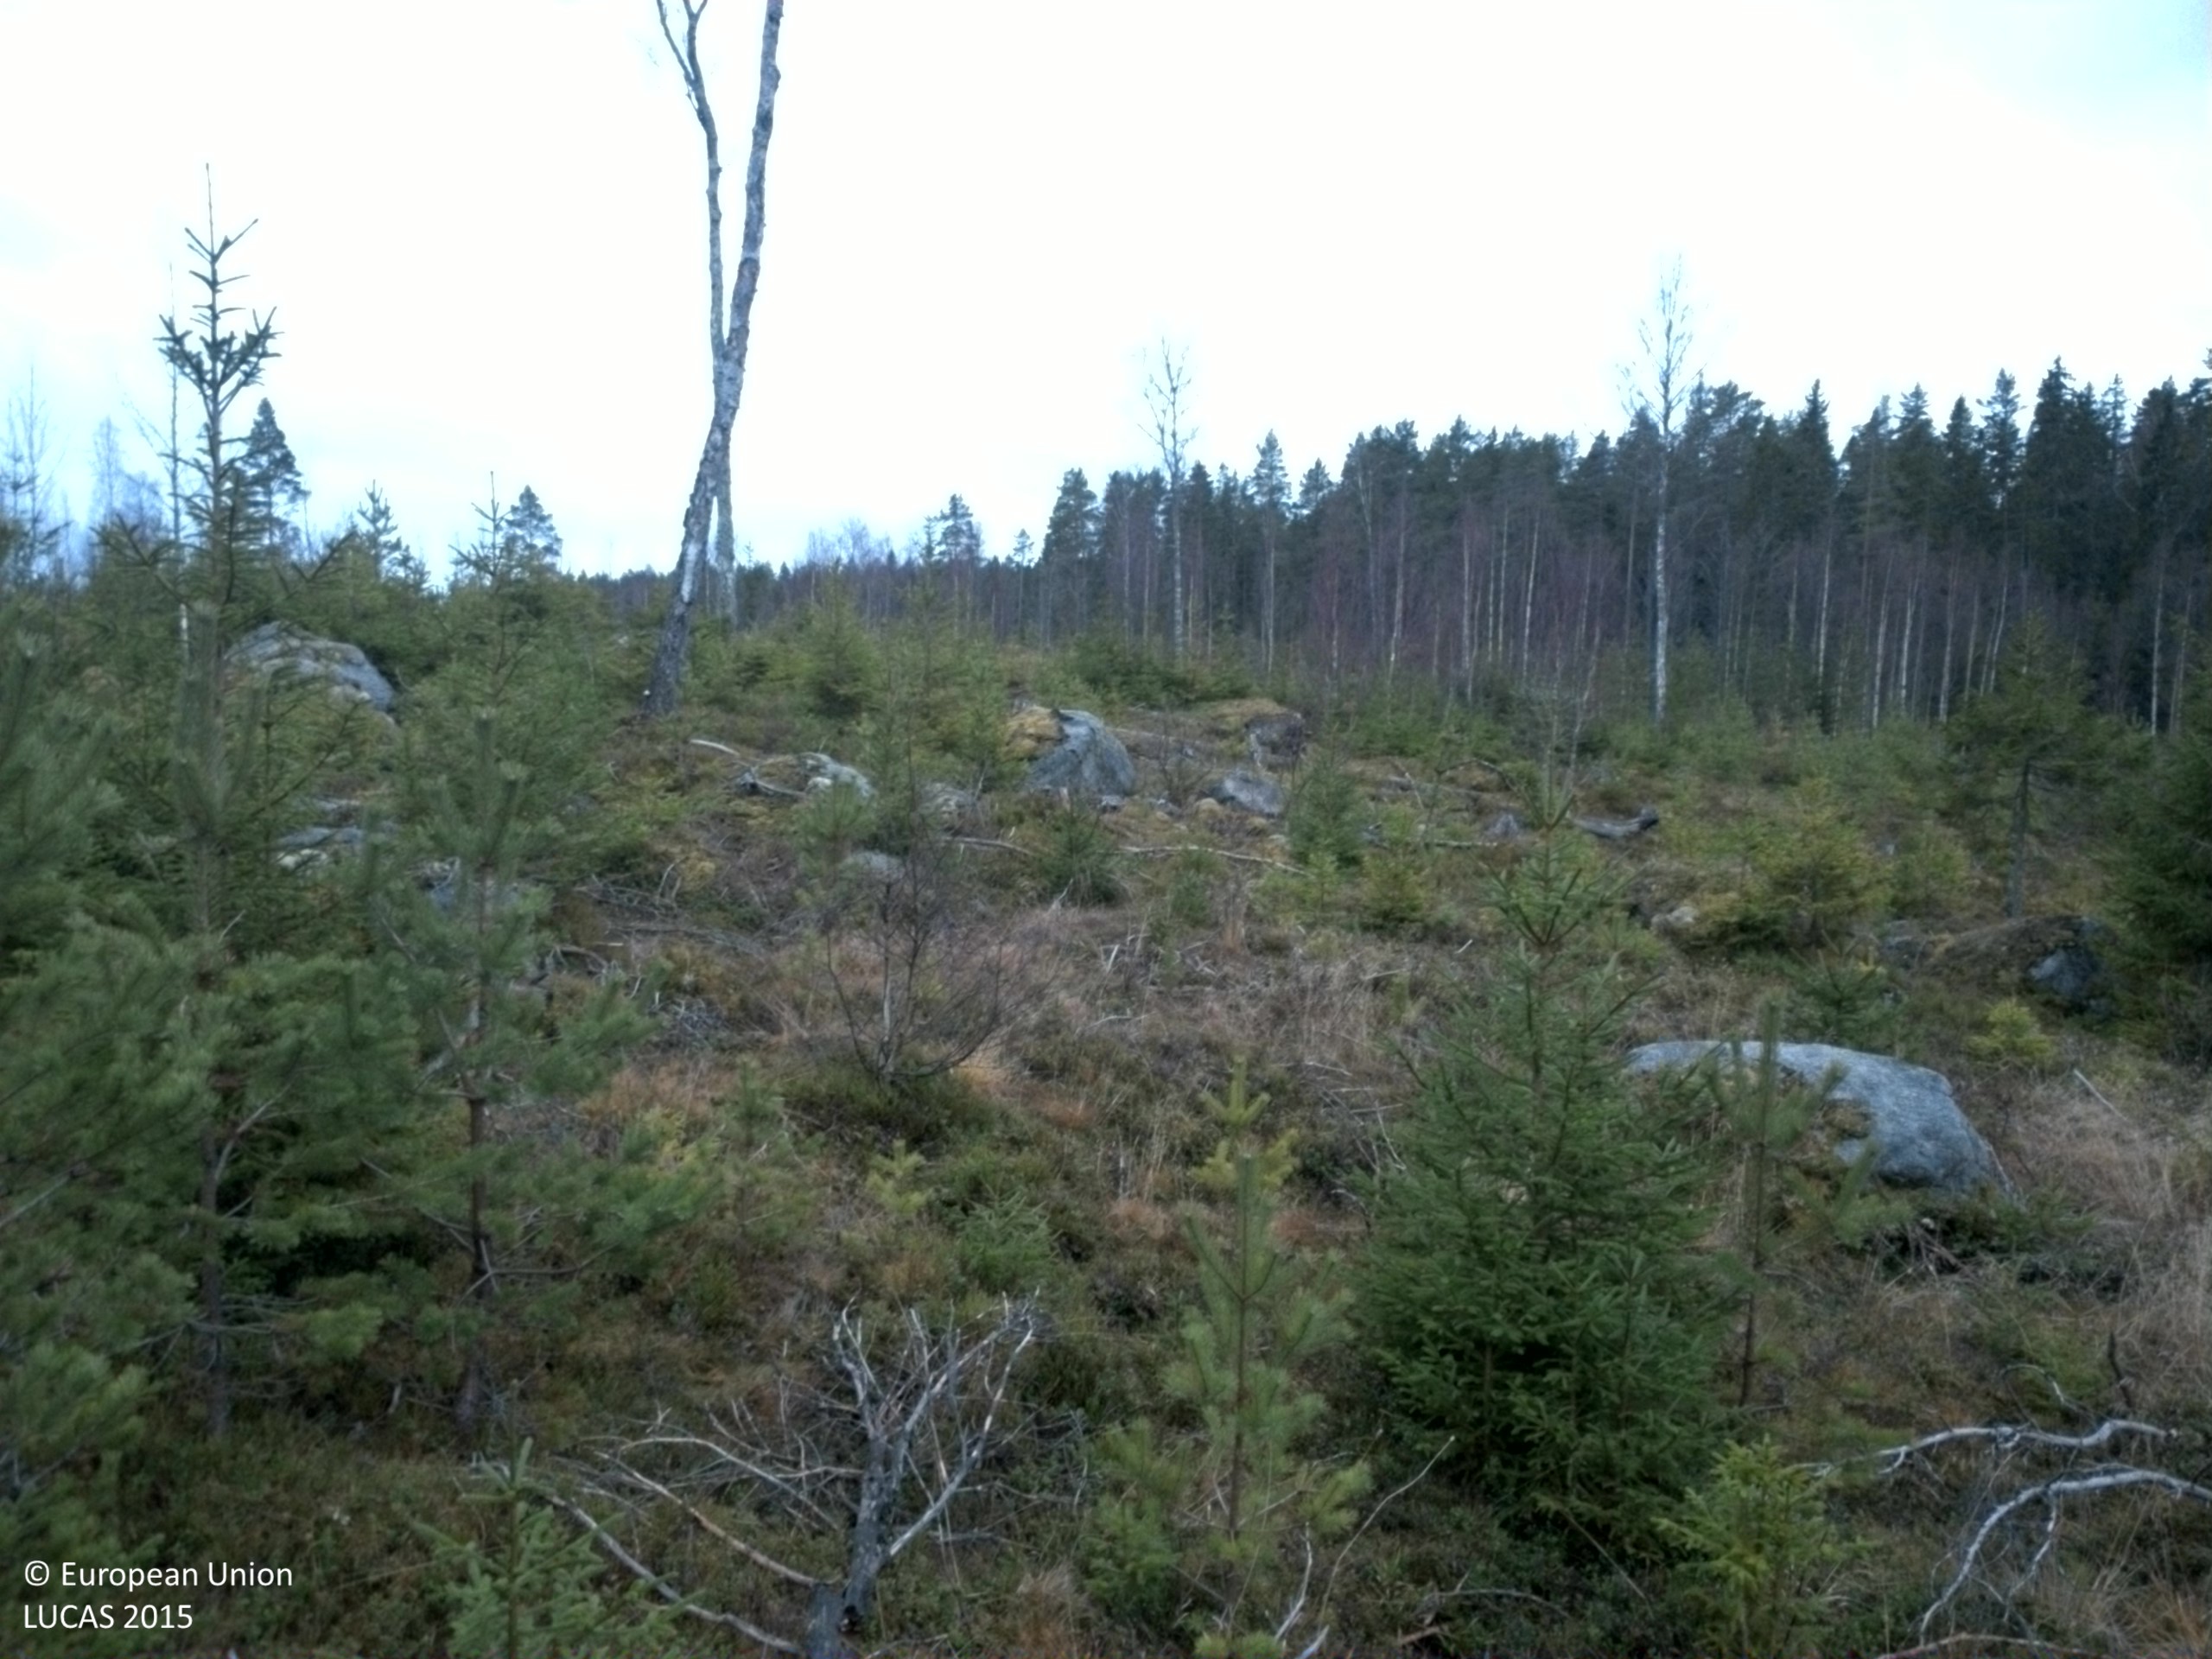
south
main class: Woodland
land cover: Other mixed woodland
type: boreal forest
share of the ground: 25 - 50 %
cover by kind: shrubs 35 %, coniferous forest trees 25 %, lichens and mosses 20 %, broadleaved forest trees 10 %, herbaceous plants 5 %, consolidated bare surface 5 %
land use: Forestry
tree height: < 5 m
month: November
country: SE
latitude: 61.5819
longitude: 16.9725
